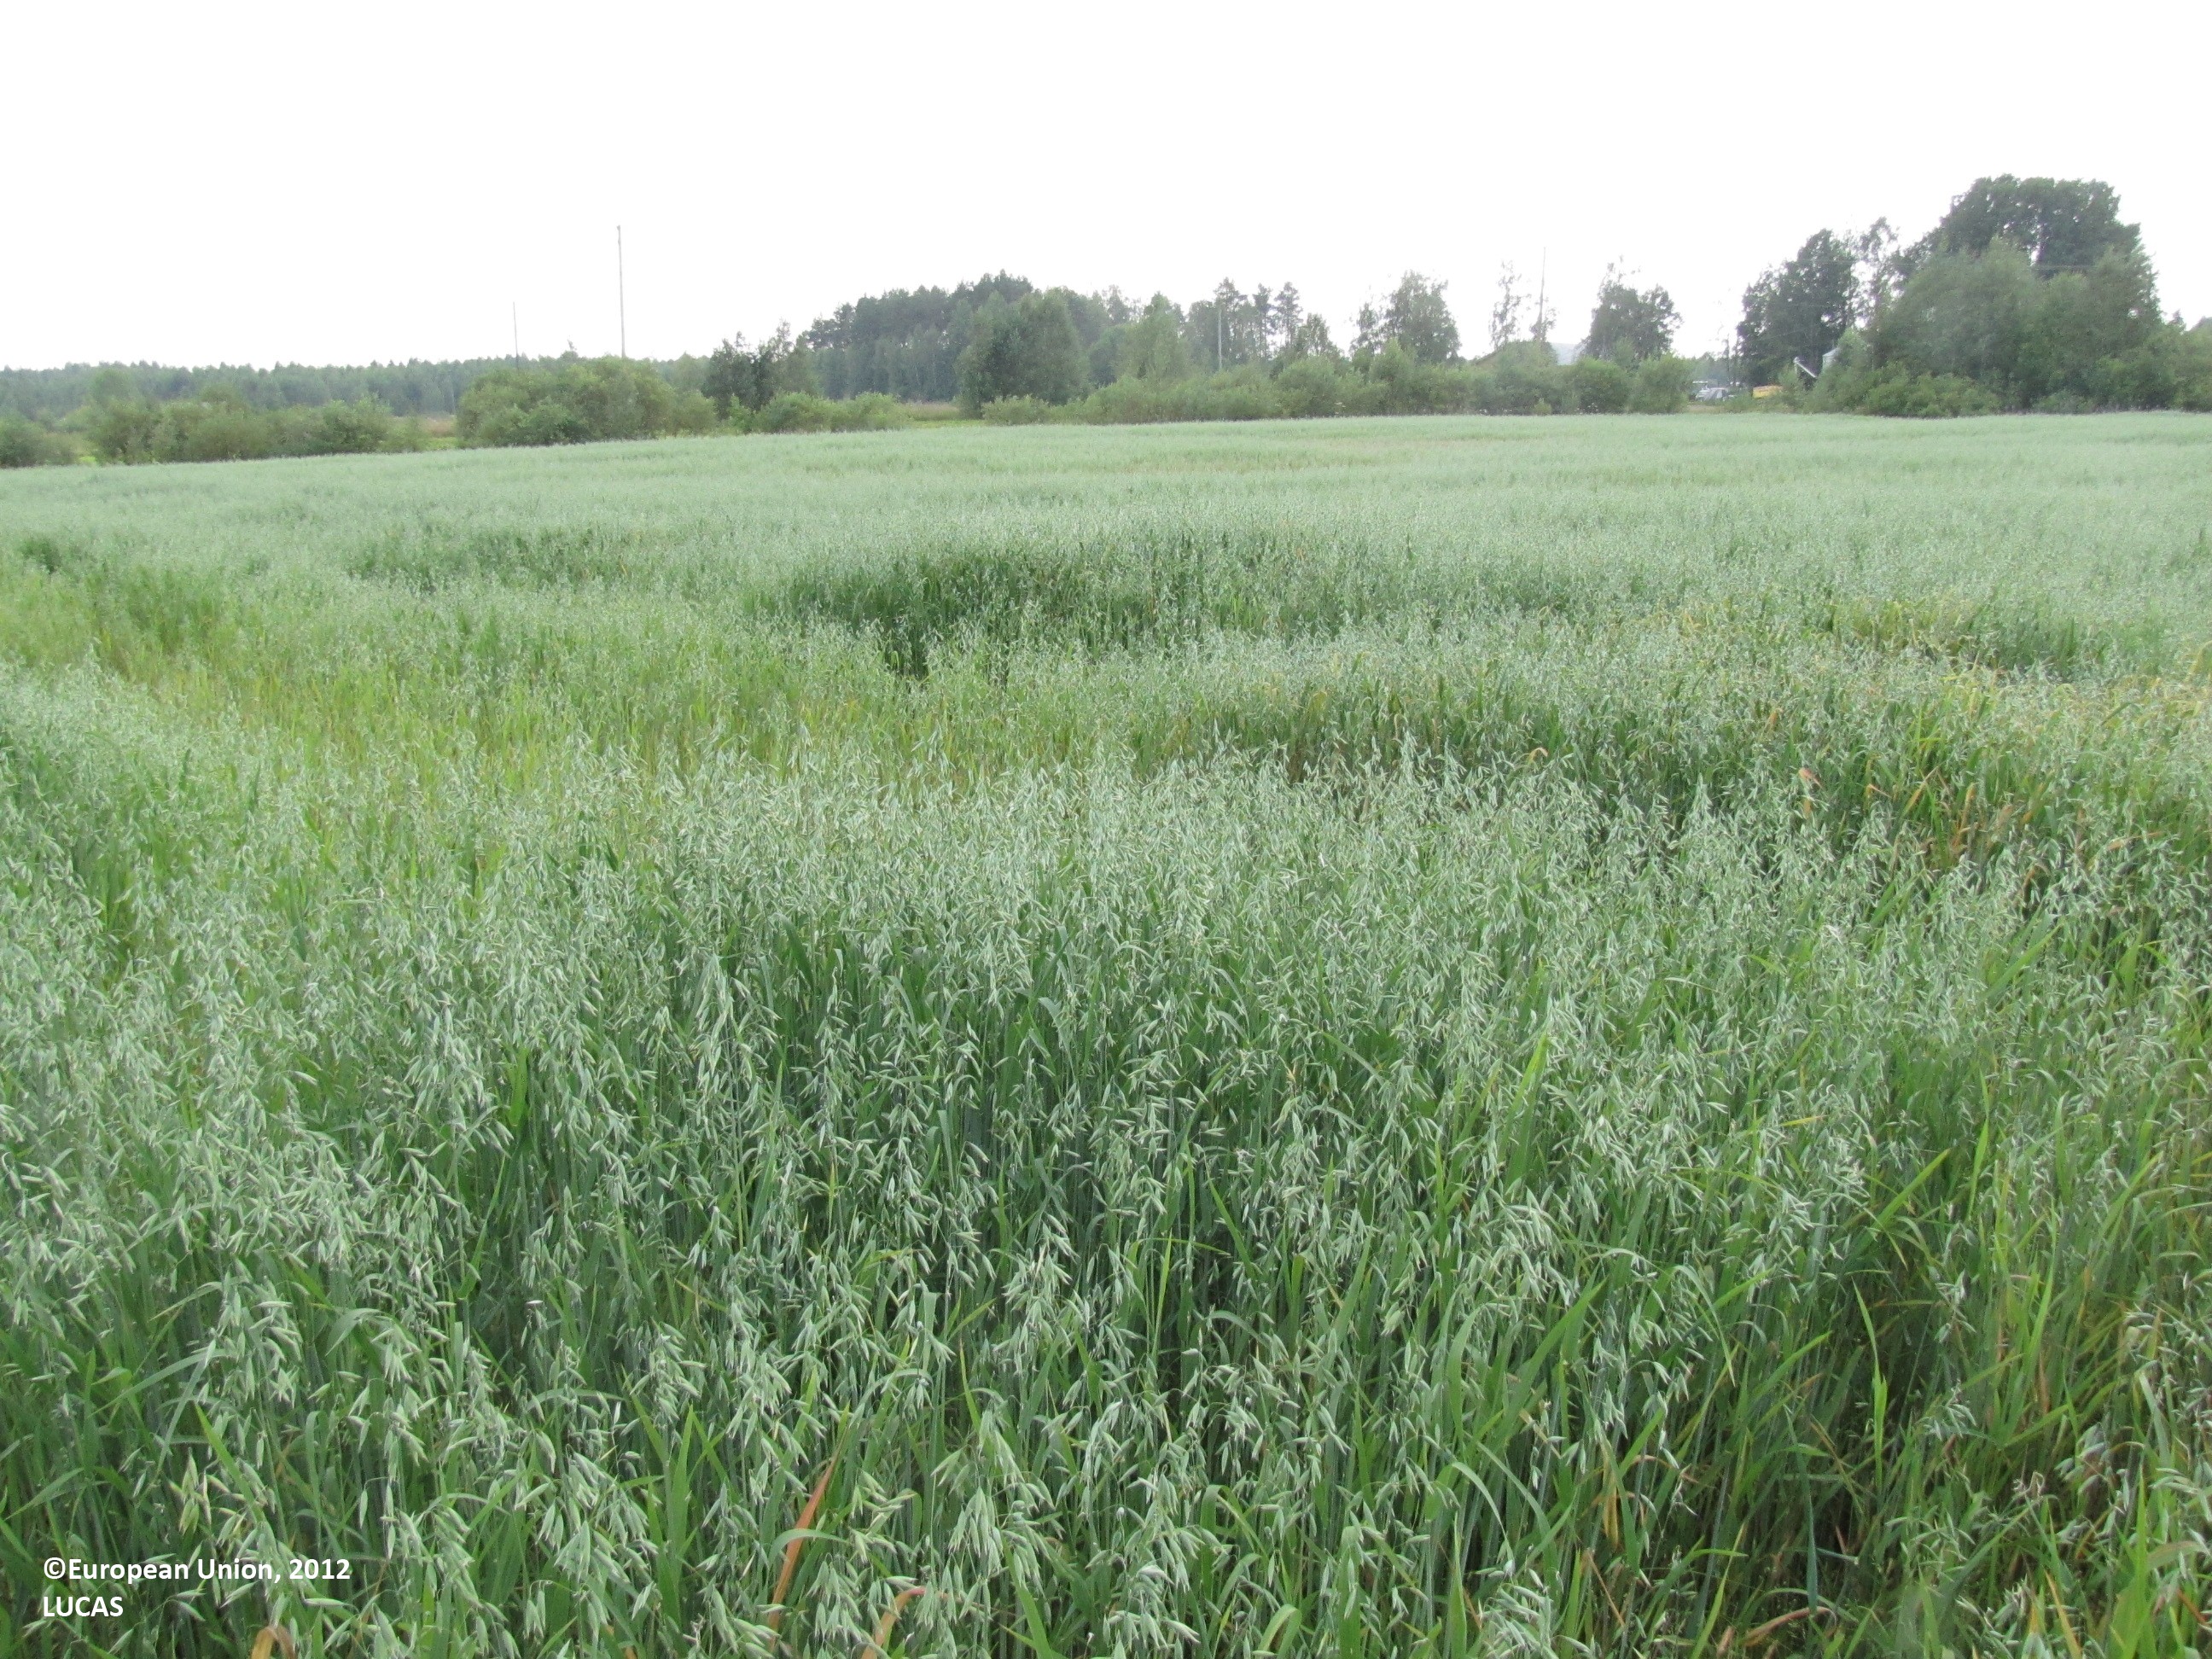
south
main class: Cropland
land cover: Oats
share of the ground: > 75 %
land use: Agriculture (excluding fallow land and kitchen gardens)
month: July
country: FI
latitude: 61.9950
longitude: 22.9526
